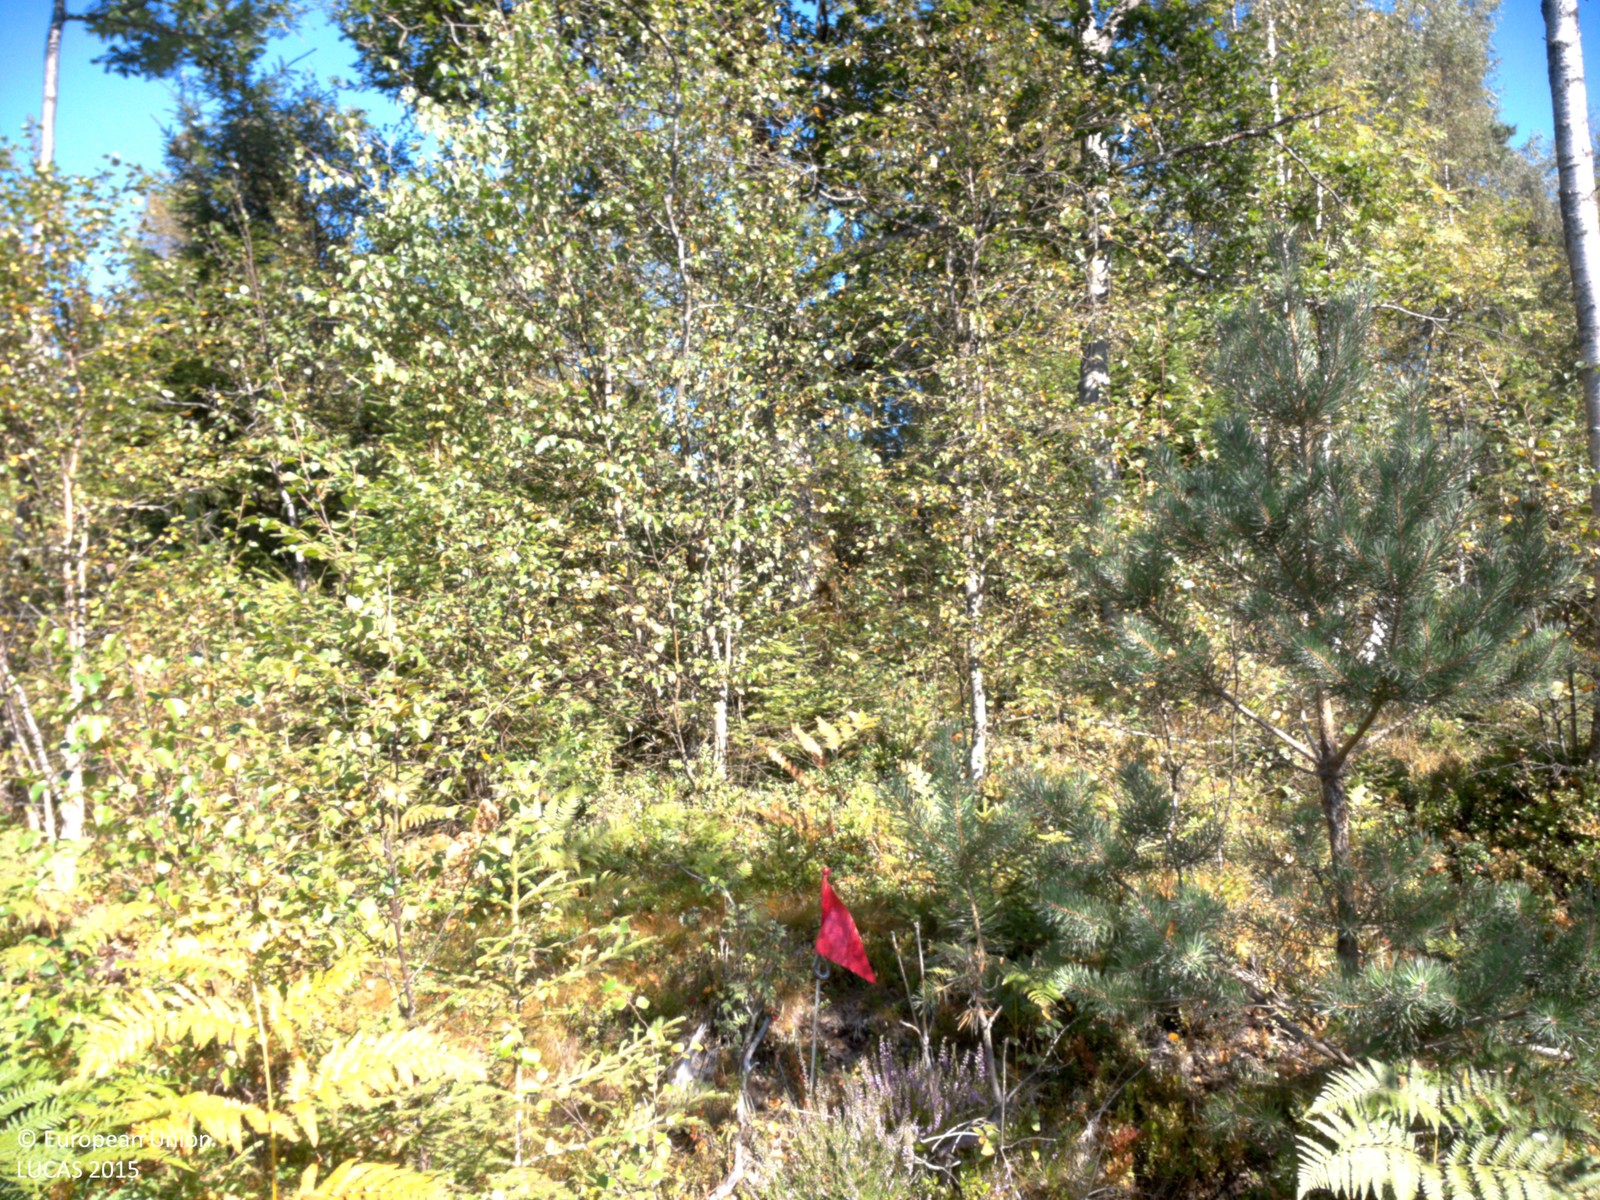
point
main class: Woodland
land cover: Pine dominated mixed woodland
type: boreal forest
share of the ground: 50 - 75 %
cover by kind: coniferous forest trees 50 %, herbaceous plants 30 %, broadleaved forest trees 20 %
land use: Forestry
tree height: > 5 m
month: August
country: SE
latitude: 58.5284
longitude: 12.0051
